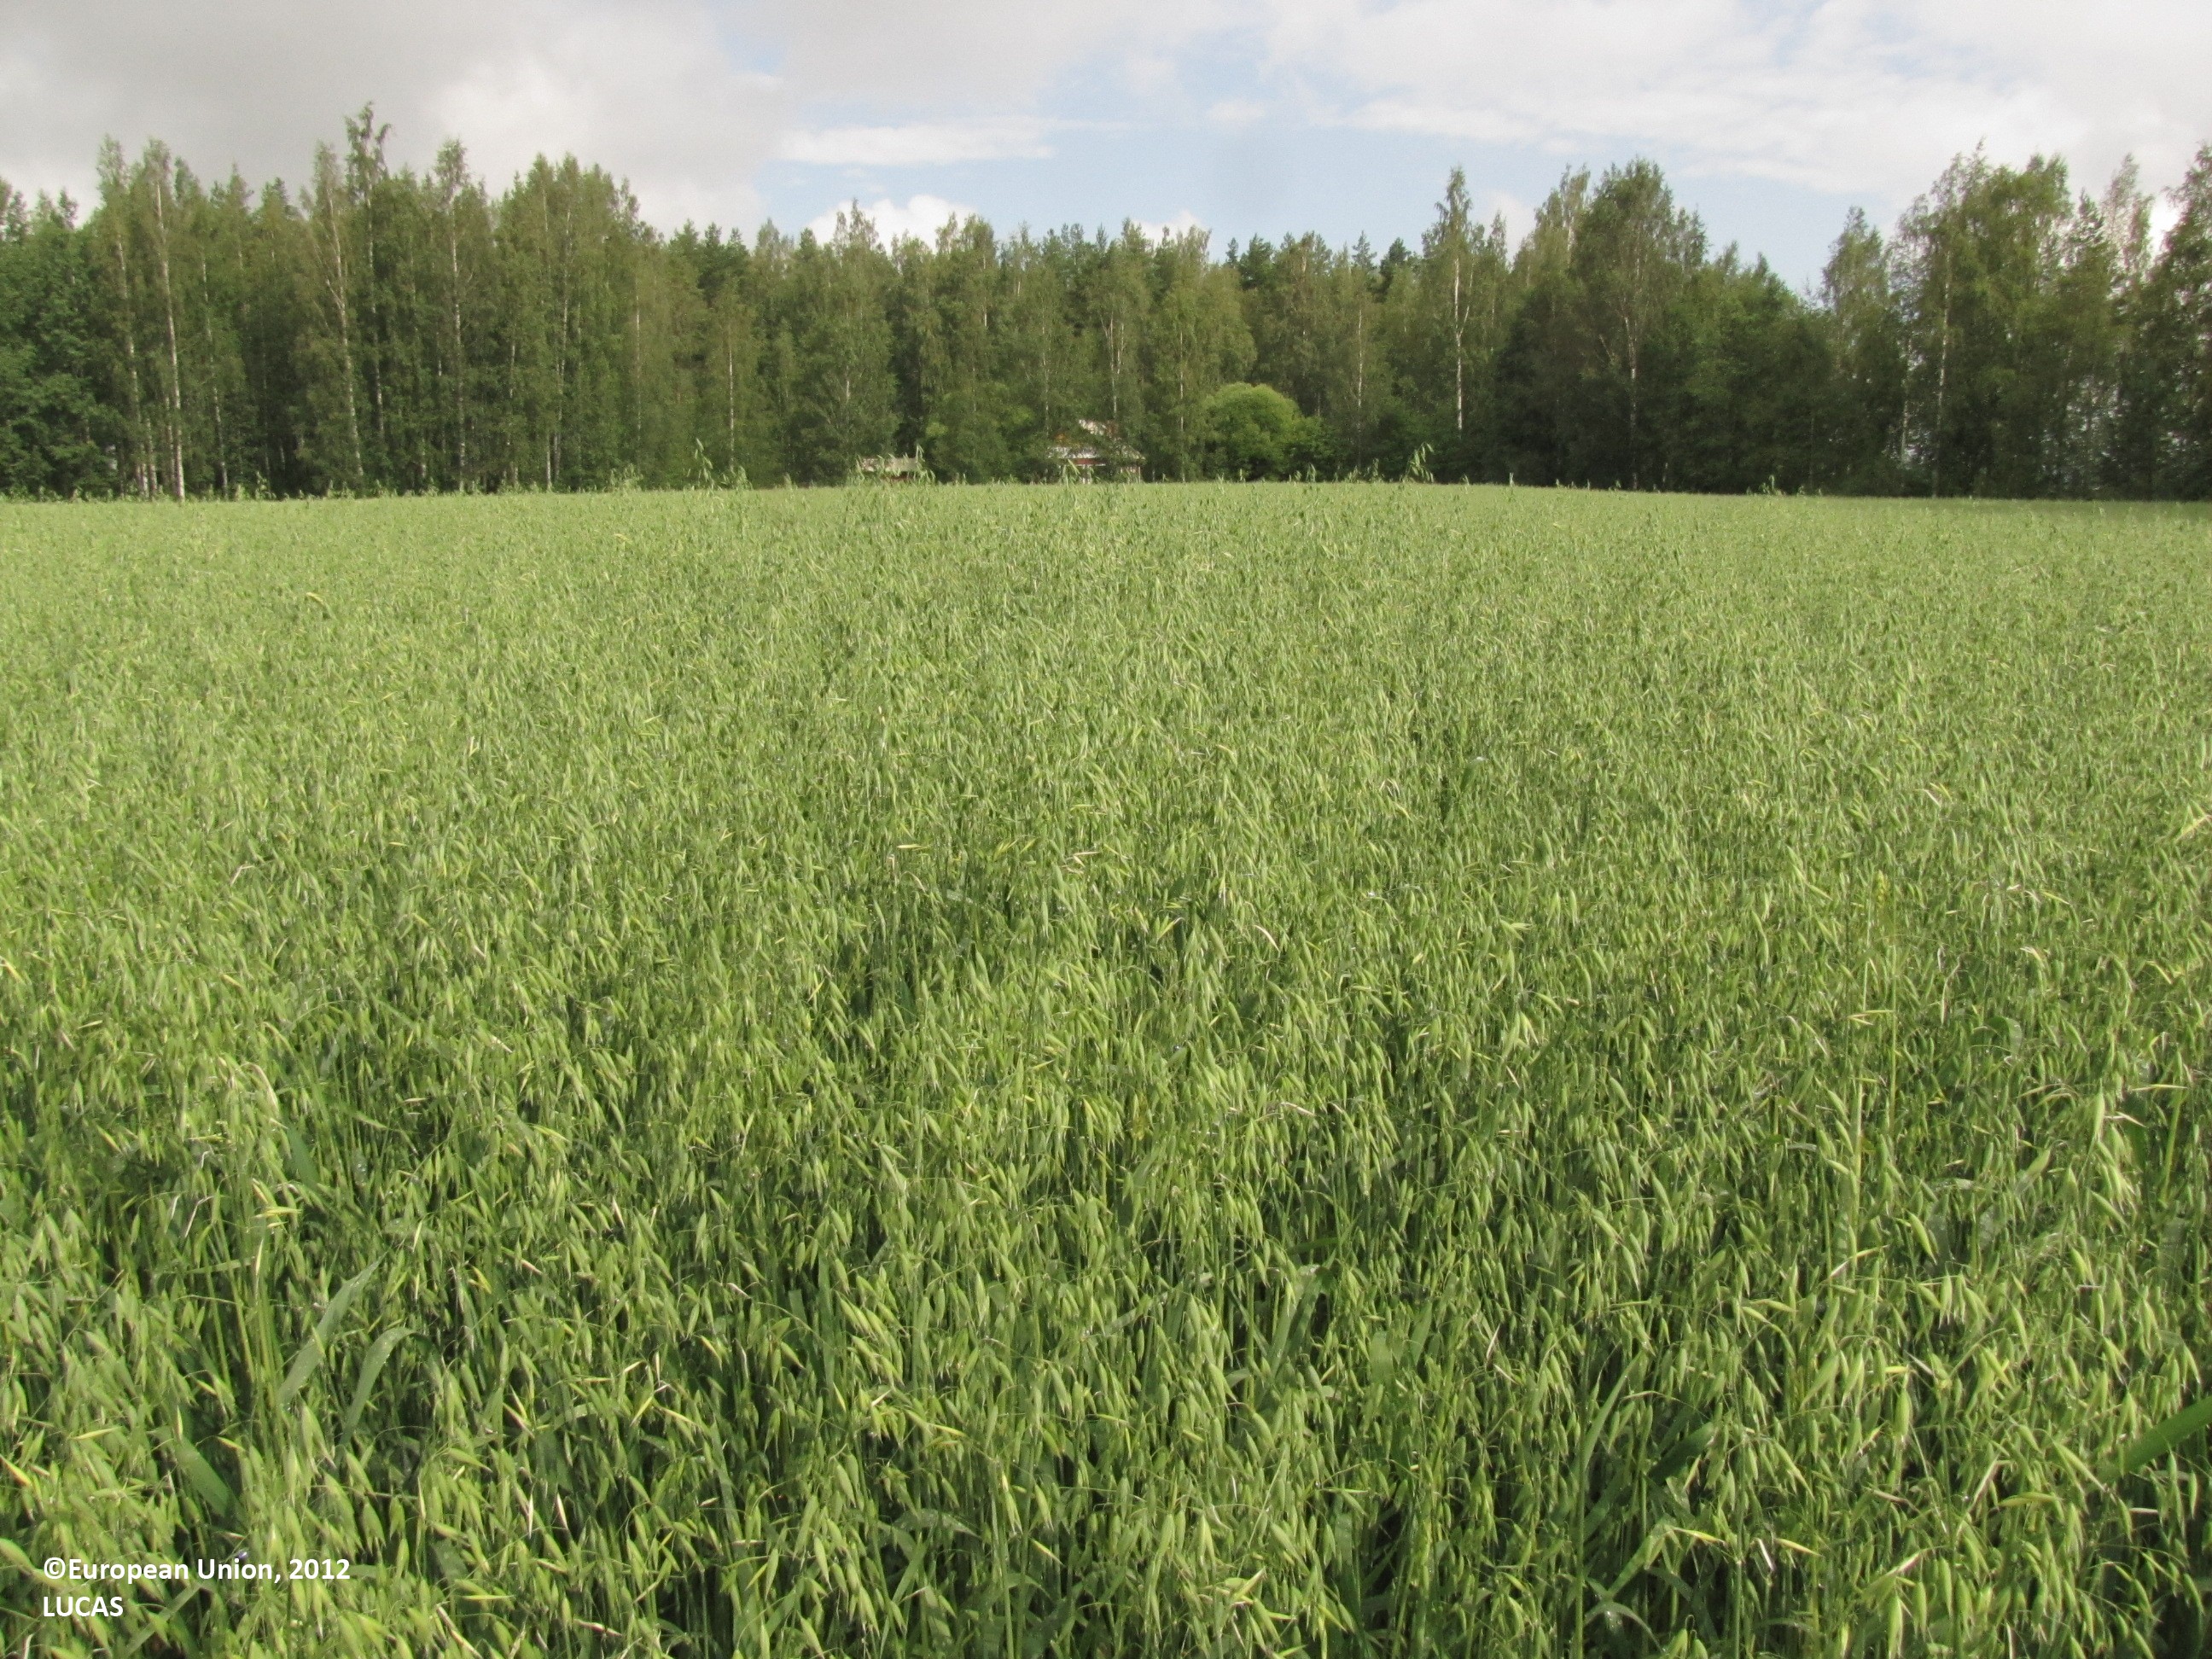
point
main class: Cropland
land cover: Oats
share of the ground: > 75 %
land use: Agriculture (excluding fallow land and kitchen gardens)
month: July
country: FI
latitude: 62.1650
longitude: 23.1026
